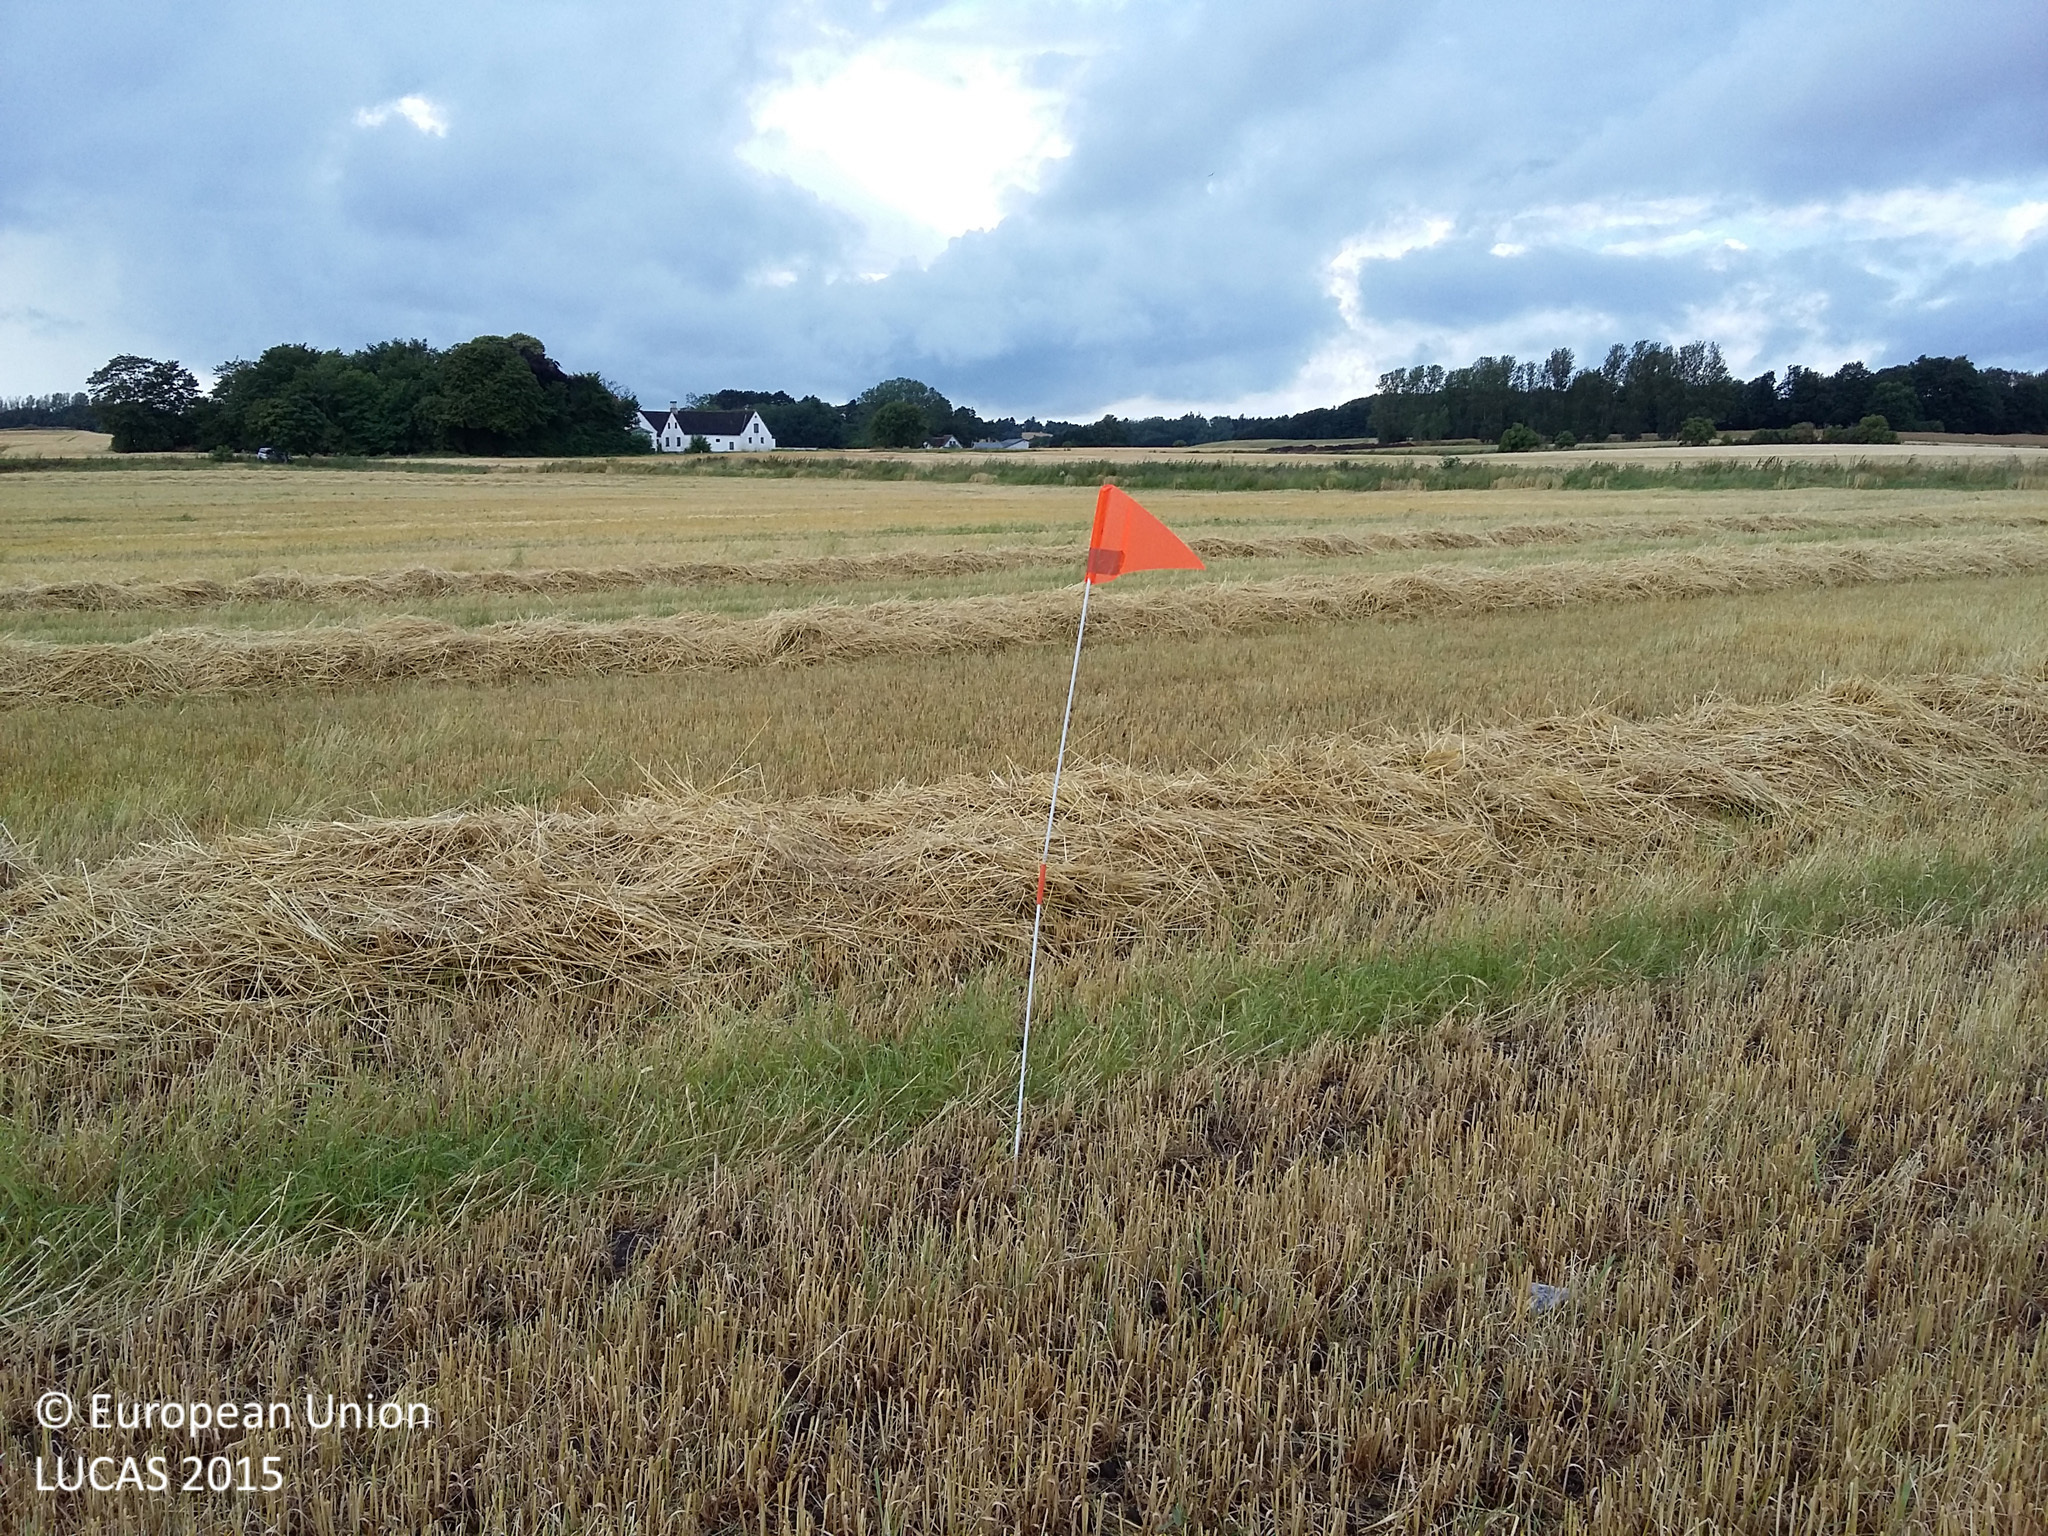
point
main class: Cropland
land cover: Barley
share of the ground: > 75 %
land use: Agriculture (excluding fallow land and kitchen gardens)
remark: Harvested field
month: July
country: DK
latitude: 55.8830
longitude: 12.0923
